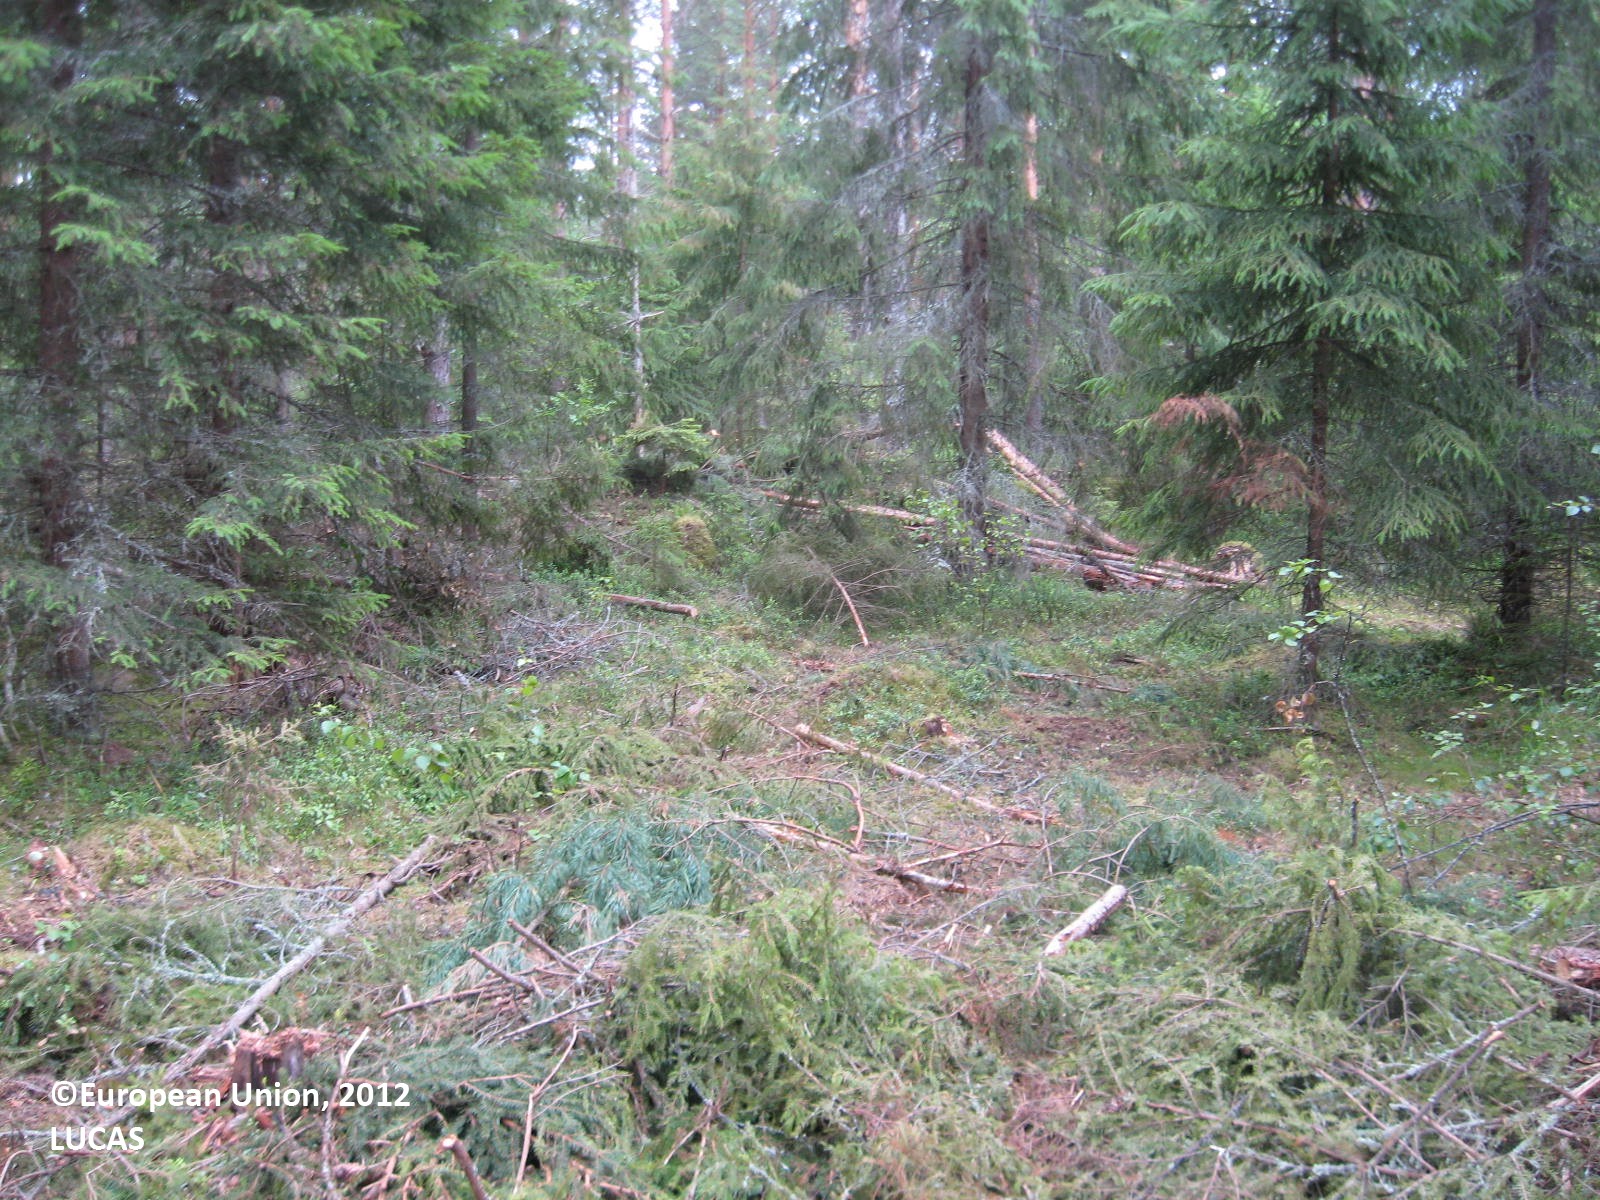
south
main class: Woodland
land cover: Other coniferous woodland
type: boreal forest
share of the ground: > 75 %
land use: Forestry
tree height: > 5 m
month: July
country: FI
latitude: 61.9155
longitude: 21.4912
